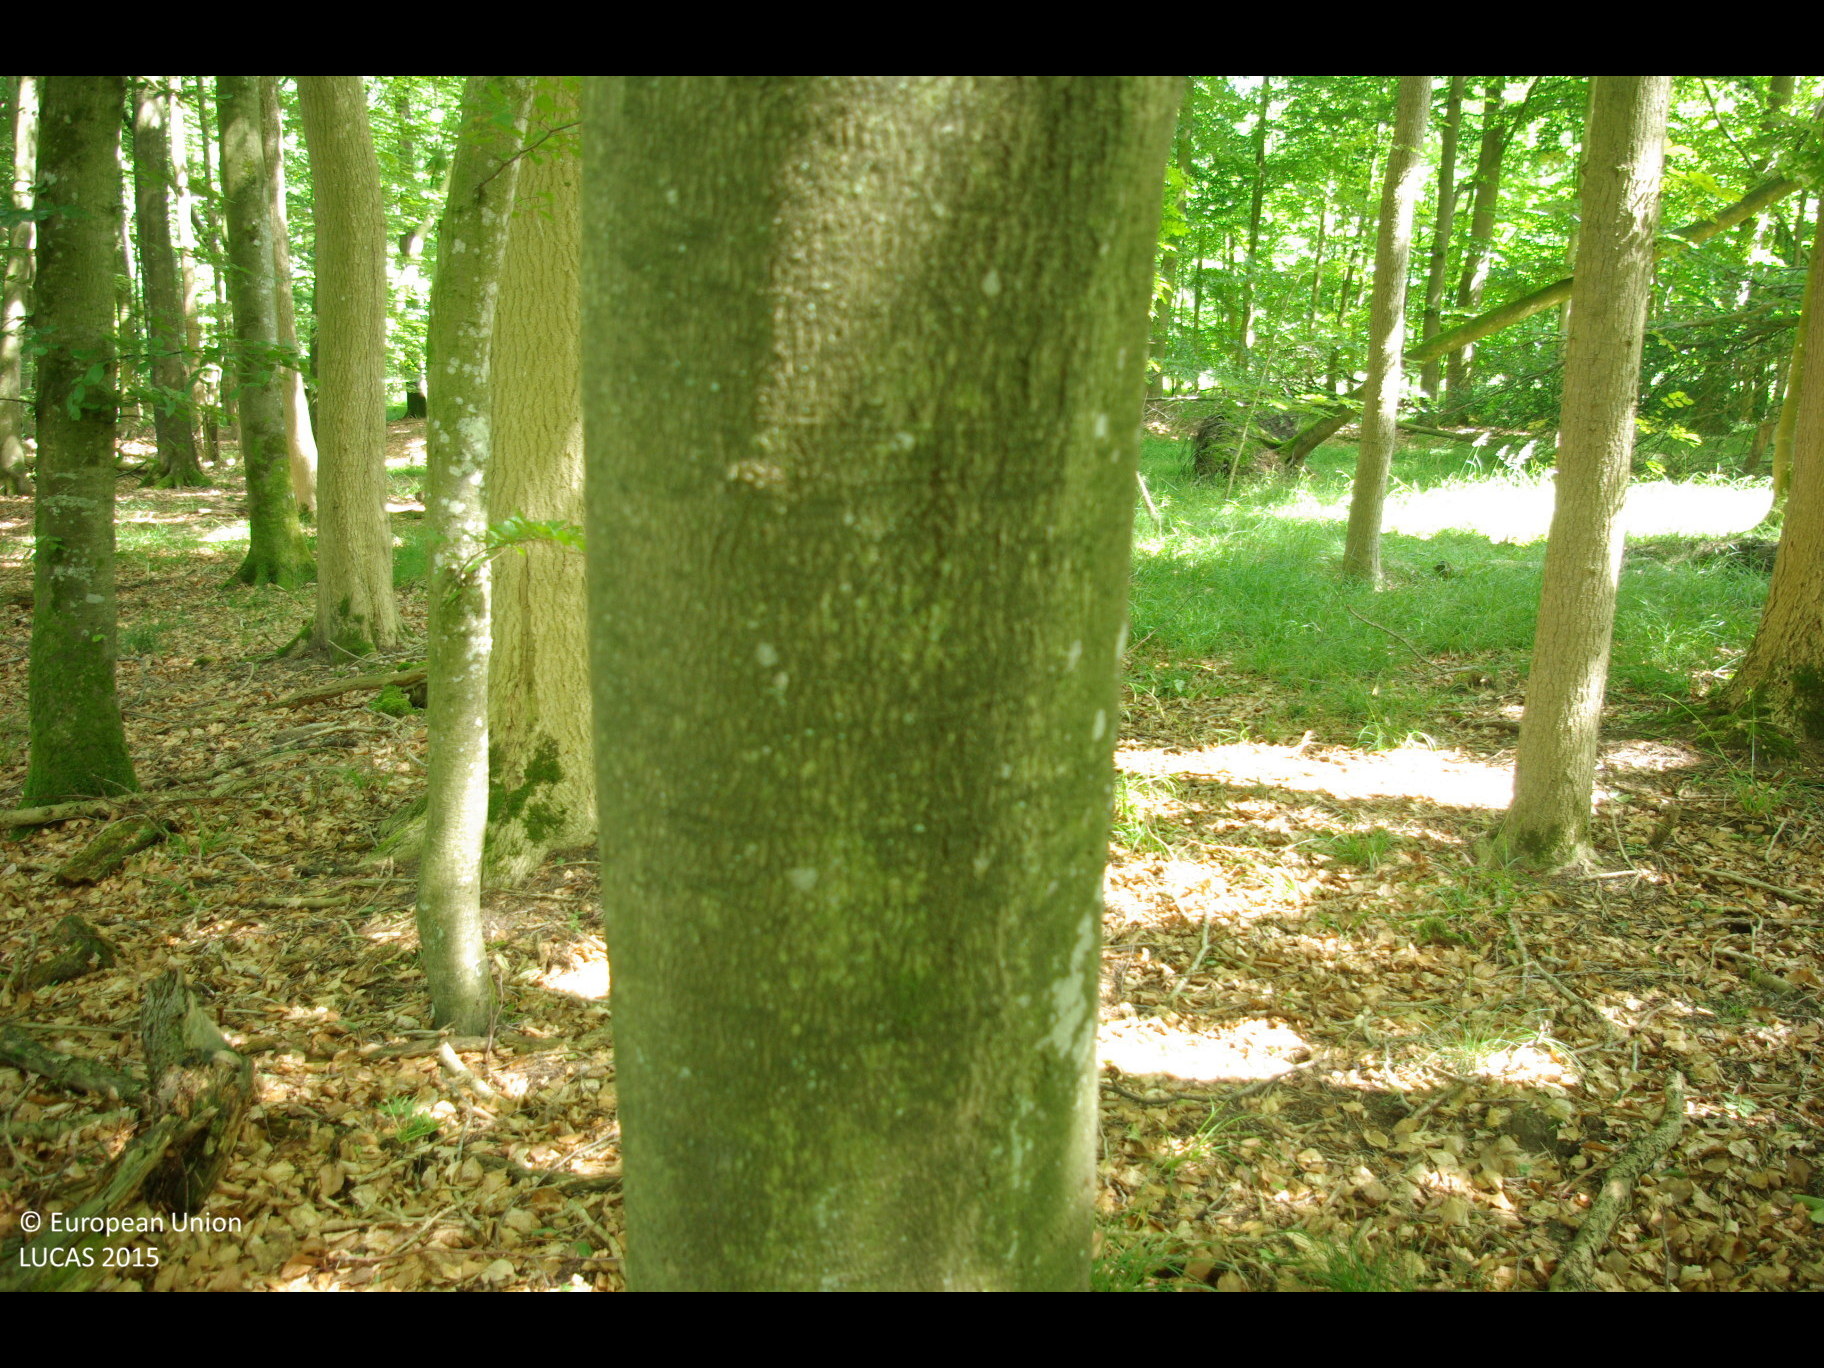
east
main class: Woodland
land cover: Broadleaved woodland
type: mesophytic deciduous forest
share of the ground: > 75 %
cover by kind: broadleaved forest trees 95 %, unconsolidated bare surface 5 %
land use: Forestry
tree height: > 5 m
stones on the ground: 10 - 25 %
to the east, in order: Broadleaved woodland; Rivers and streams; Broadleaved woodland; Rivers and streams; Broadleaved woodland; Rivers and streams; Spruce dominated mixed woodland
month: July
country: DE
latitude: 54.3884
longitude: 9.3075
